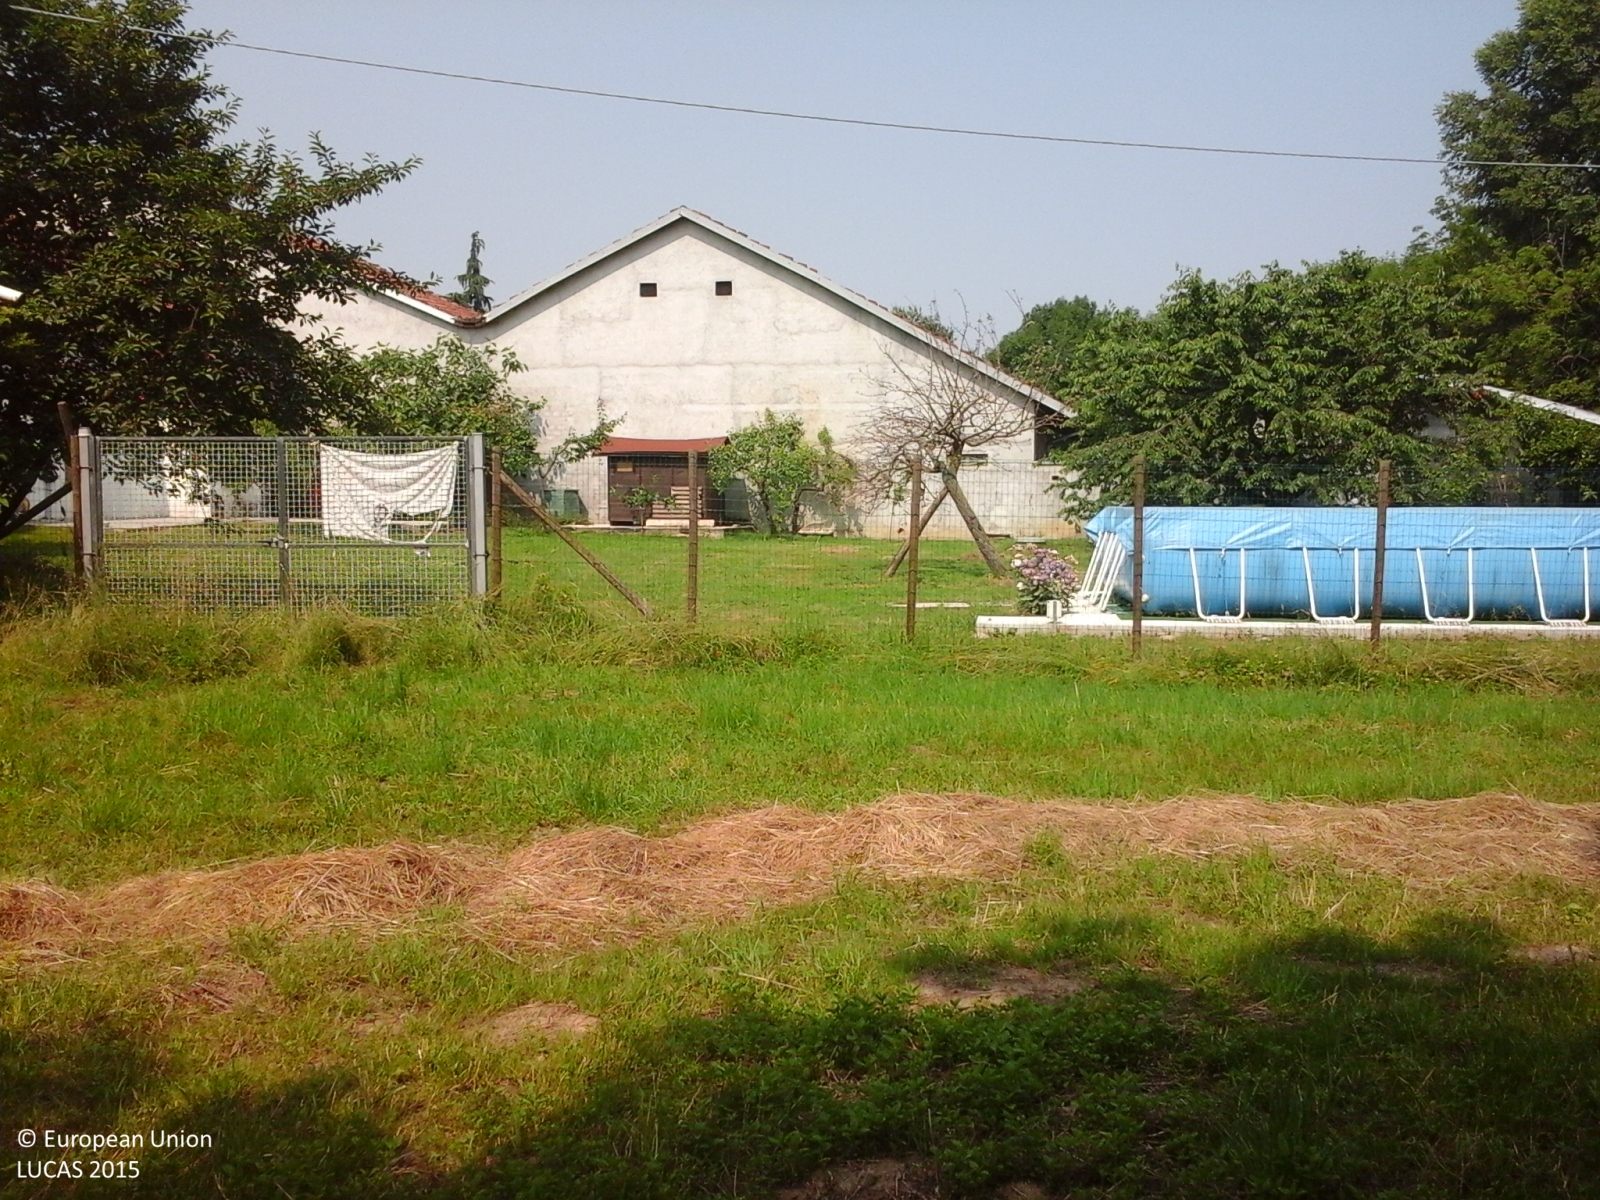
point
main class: Grassland
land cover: Grassland with sparse tree/shrub cover
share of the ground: > 75 %
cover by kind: herbaceous plants 90 %, broadleaved forest trees 5 %, shrubs 5 %
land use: Residential
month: May
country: IT
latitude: 45.2264
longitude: 7.6732
